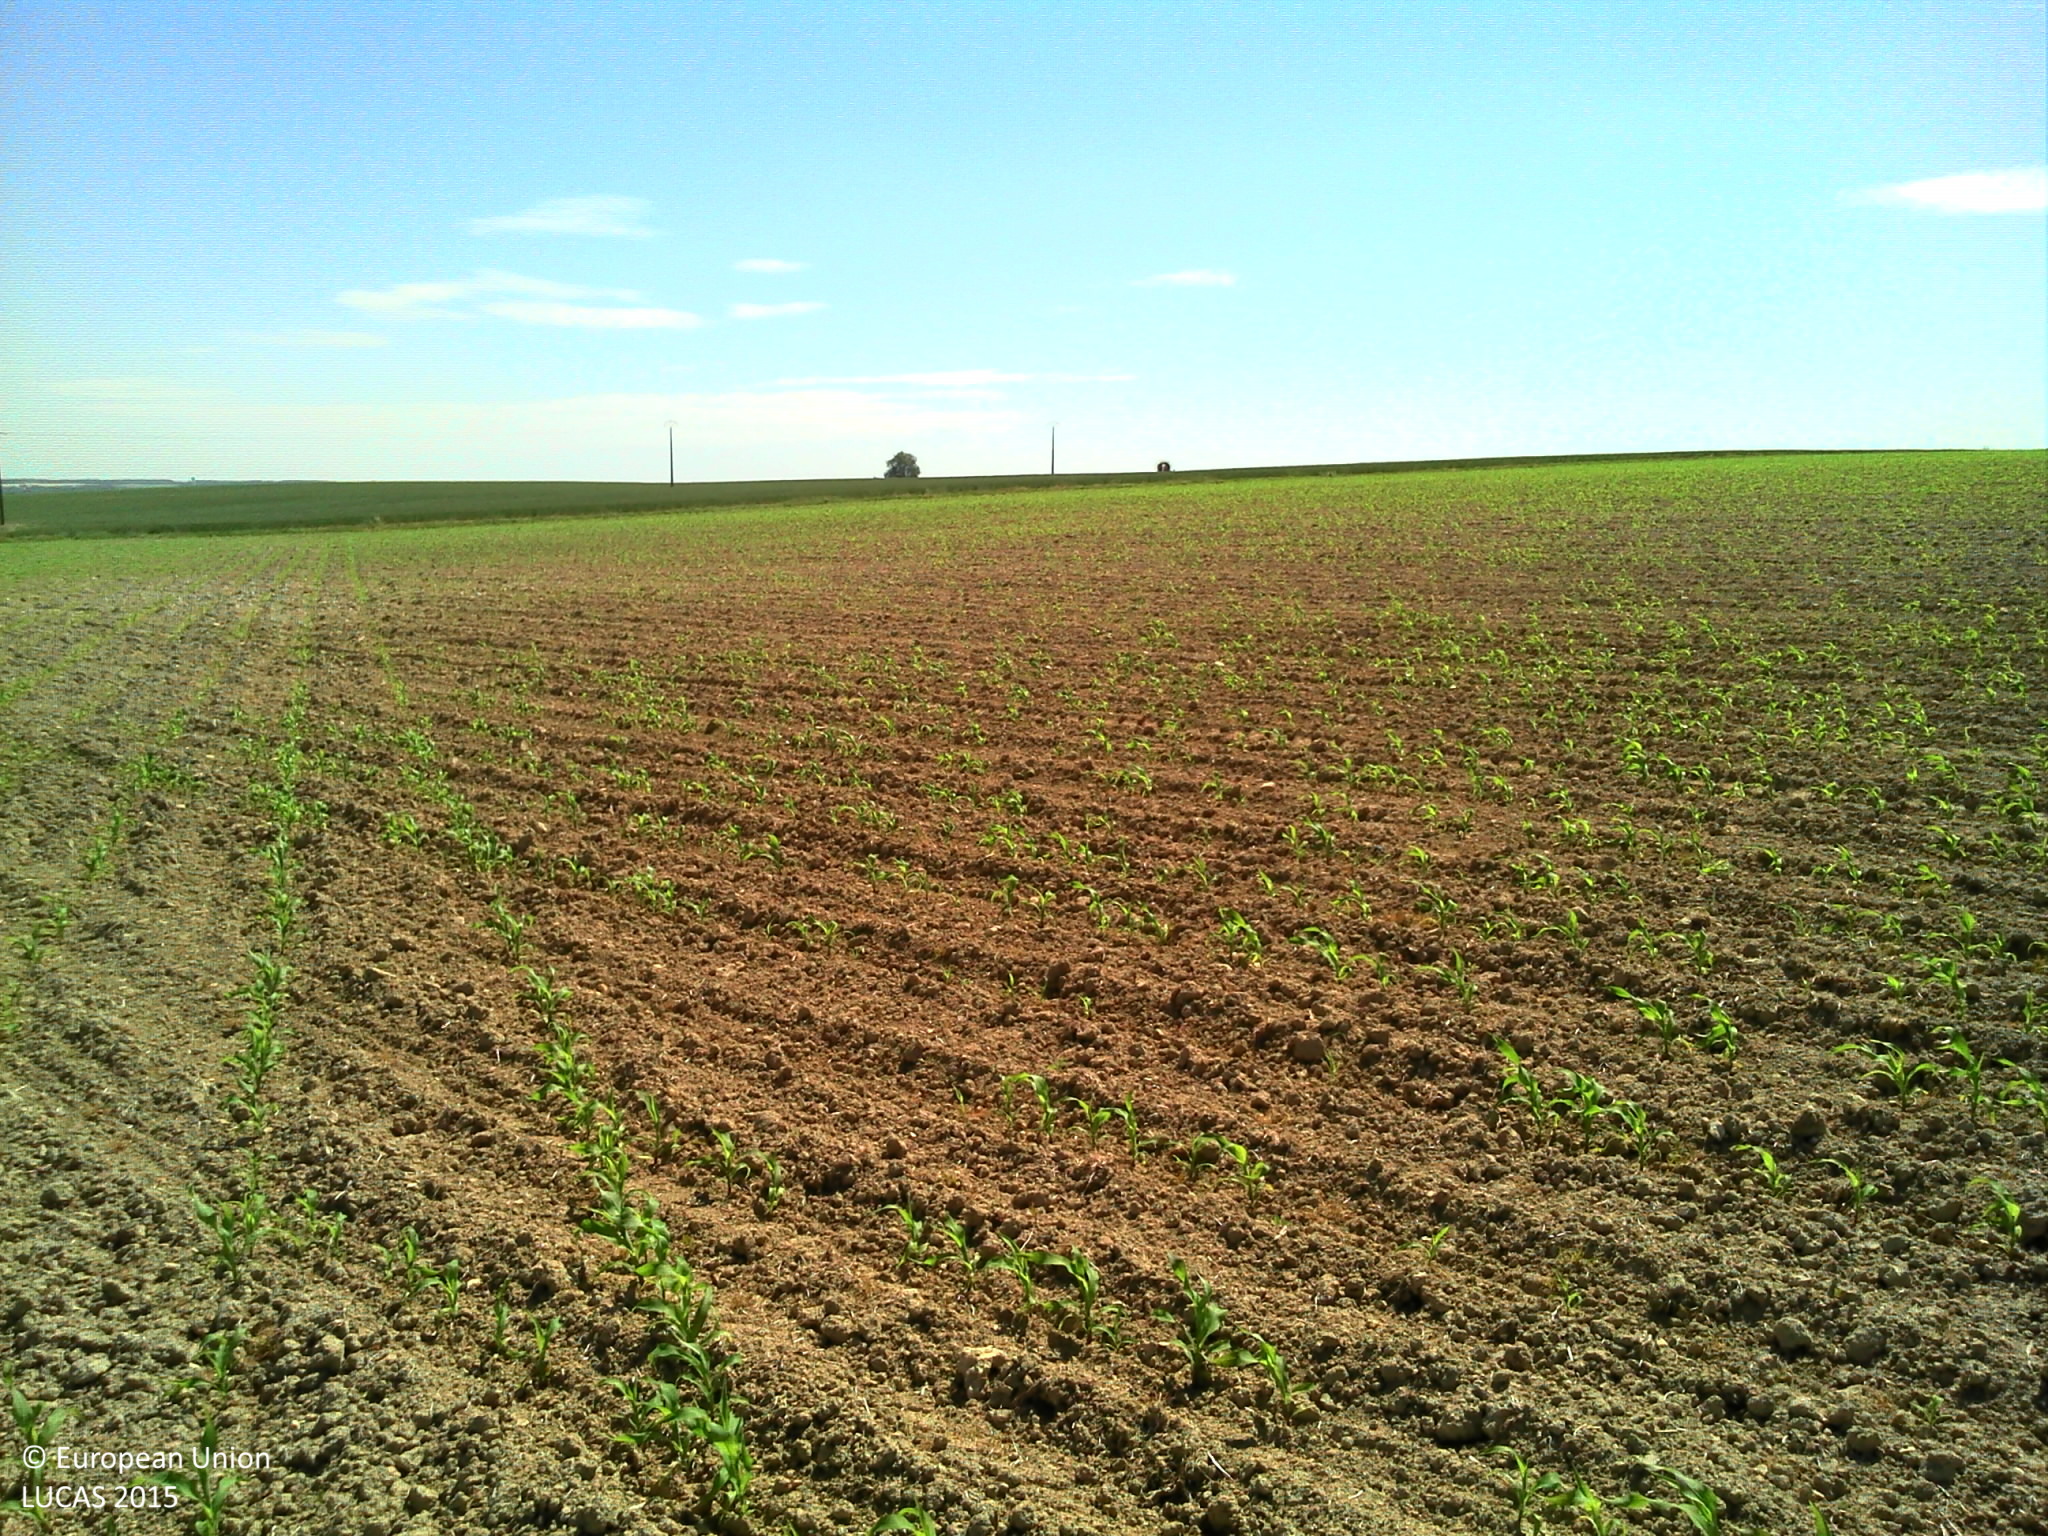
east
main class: Cropland
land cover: Maize
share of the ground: 10 - 25 %
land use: Agriculture (excluding fallow land and kitchen gardens)
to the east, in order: Maize; Grass margins; Tracks; Grass margins; Common wheat
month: June
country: FR
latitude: 46.9100
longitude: 0.5413
